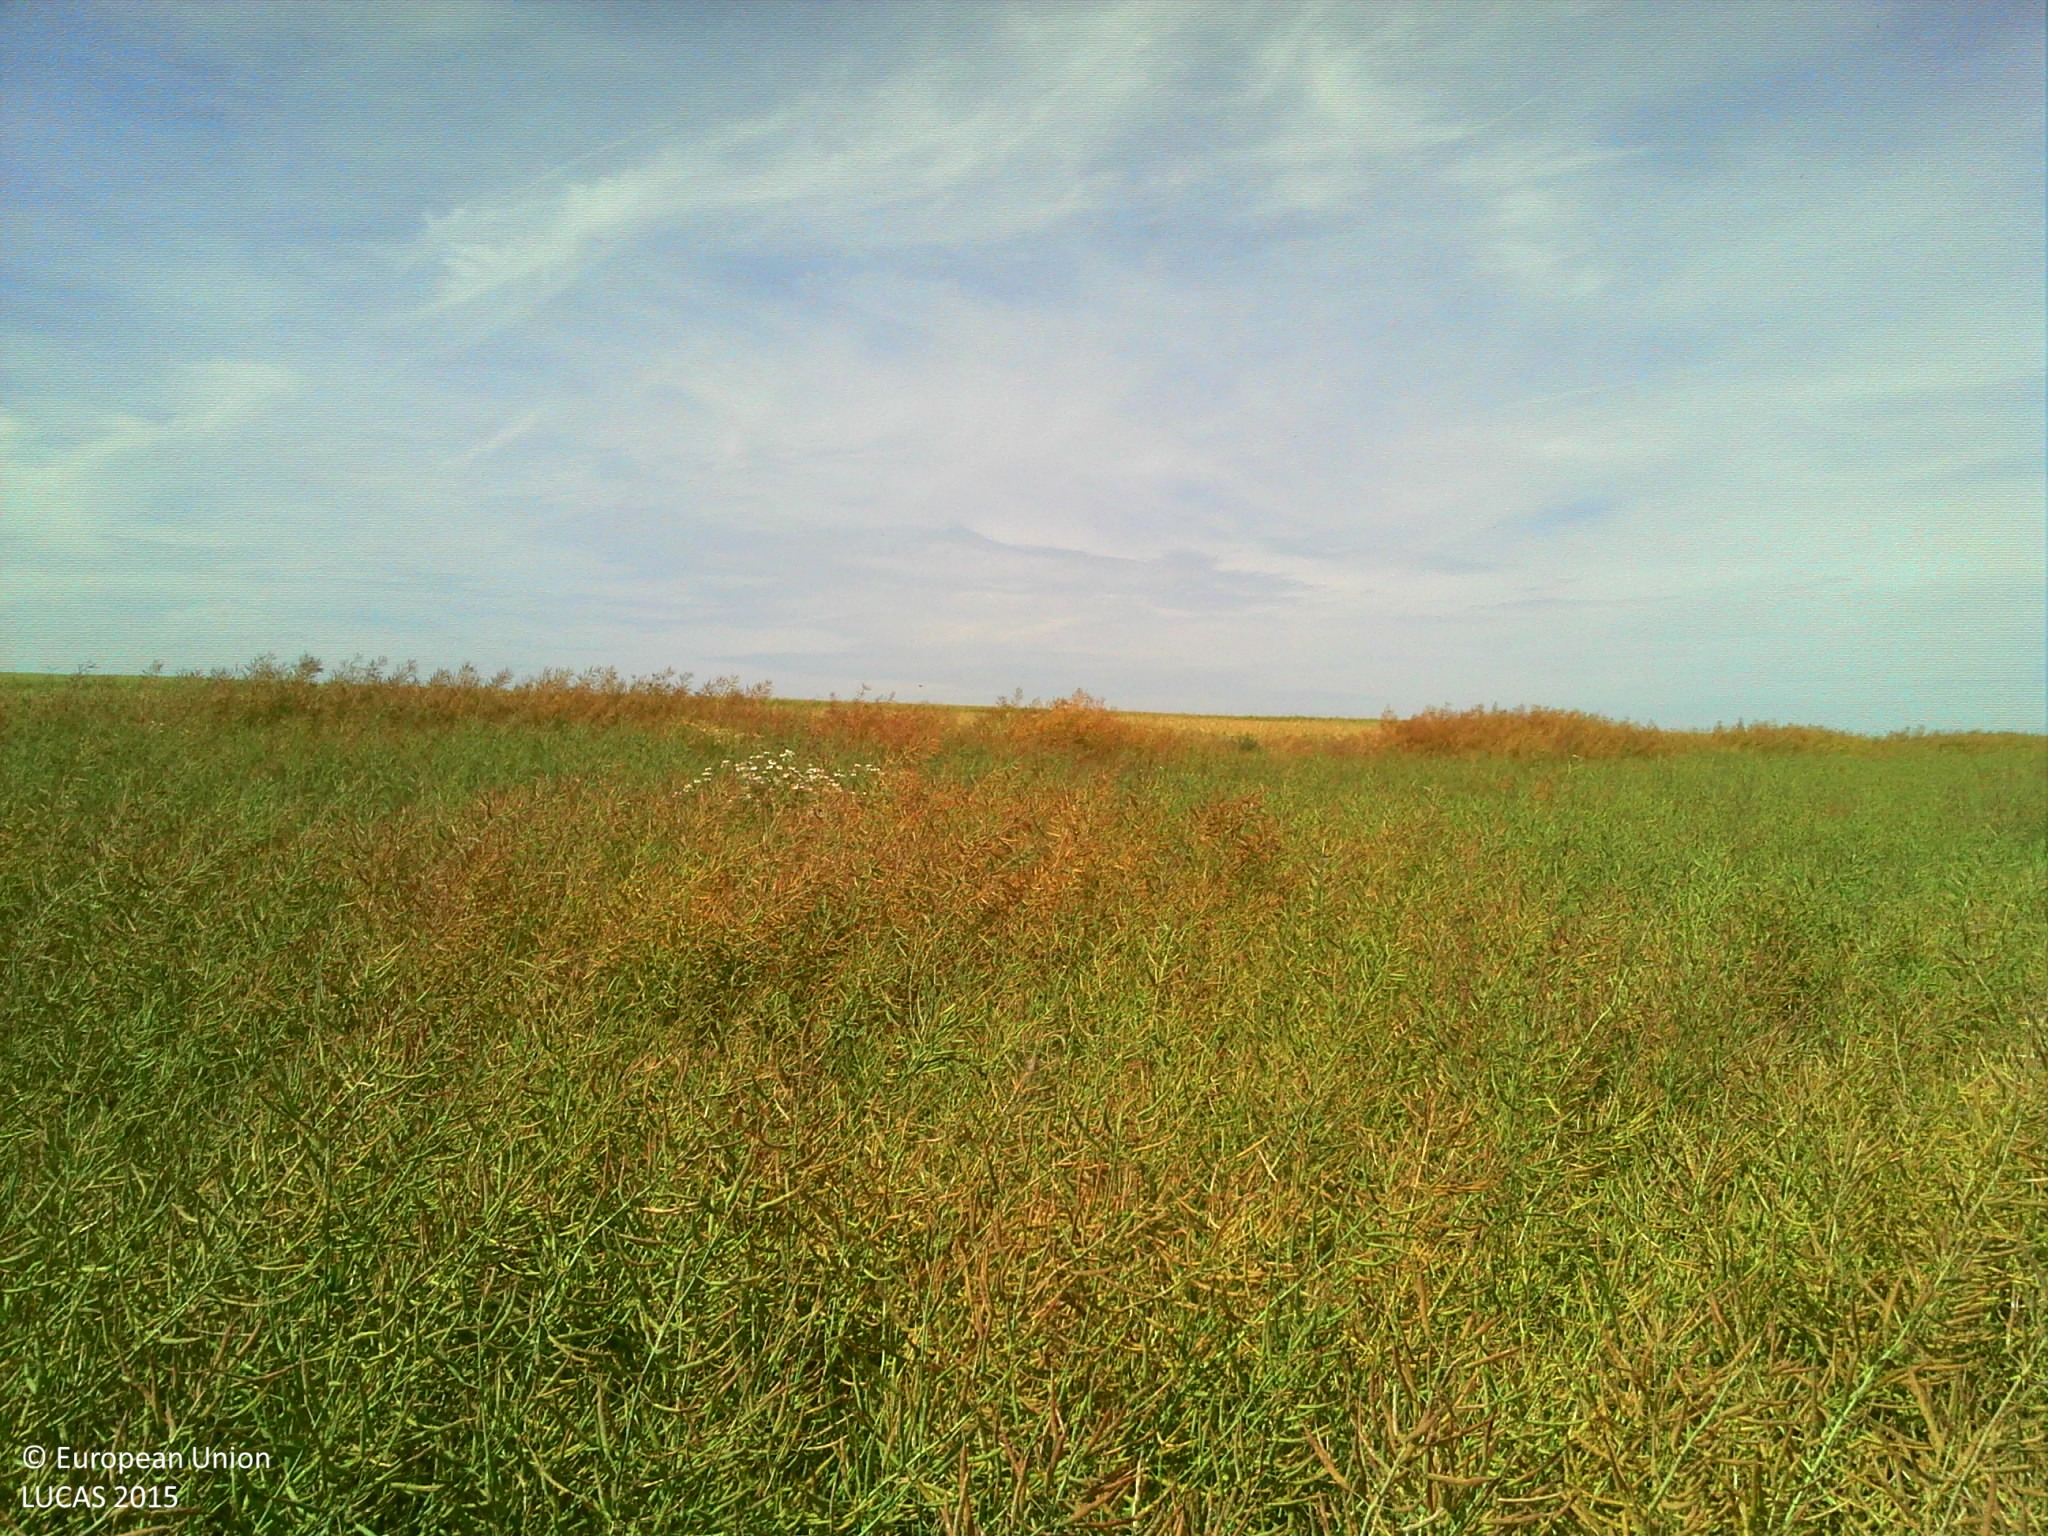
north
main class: Cropland
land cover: Rape and turnip rape
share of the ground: > 75 %
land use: Agriculture (excluding fallow land and kitchen gardens)
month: June
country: FR
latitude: 49.4936
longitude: 2.3523
